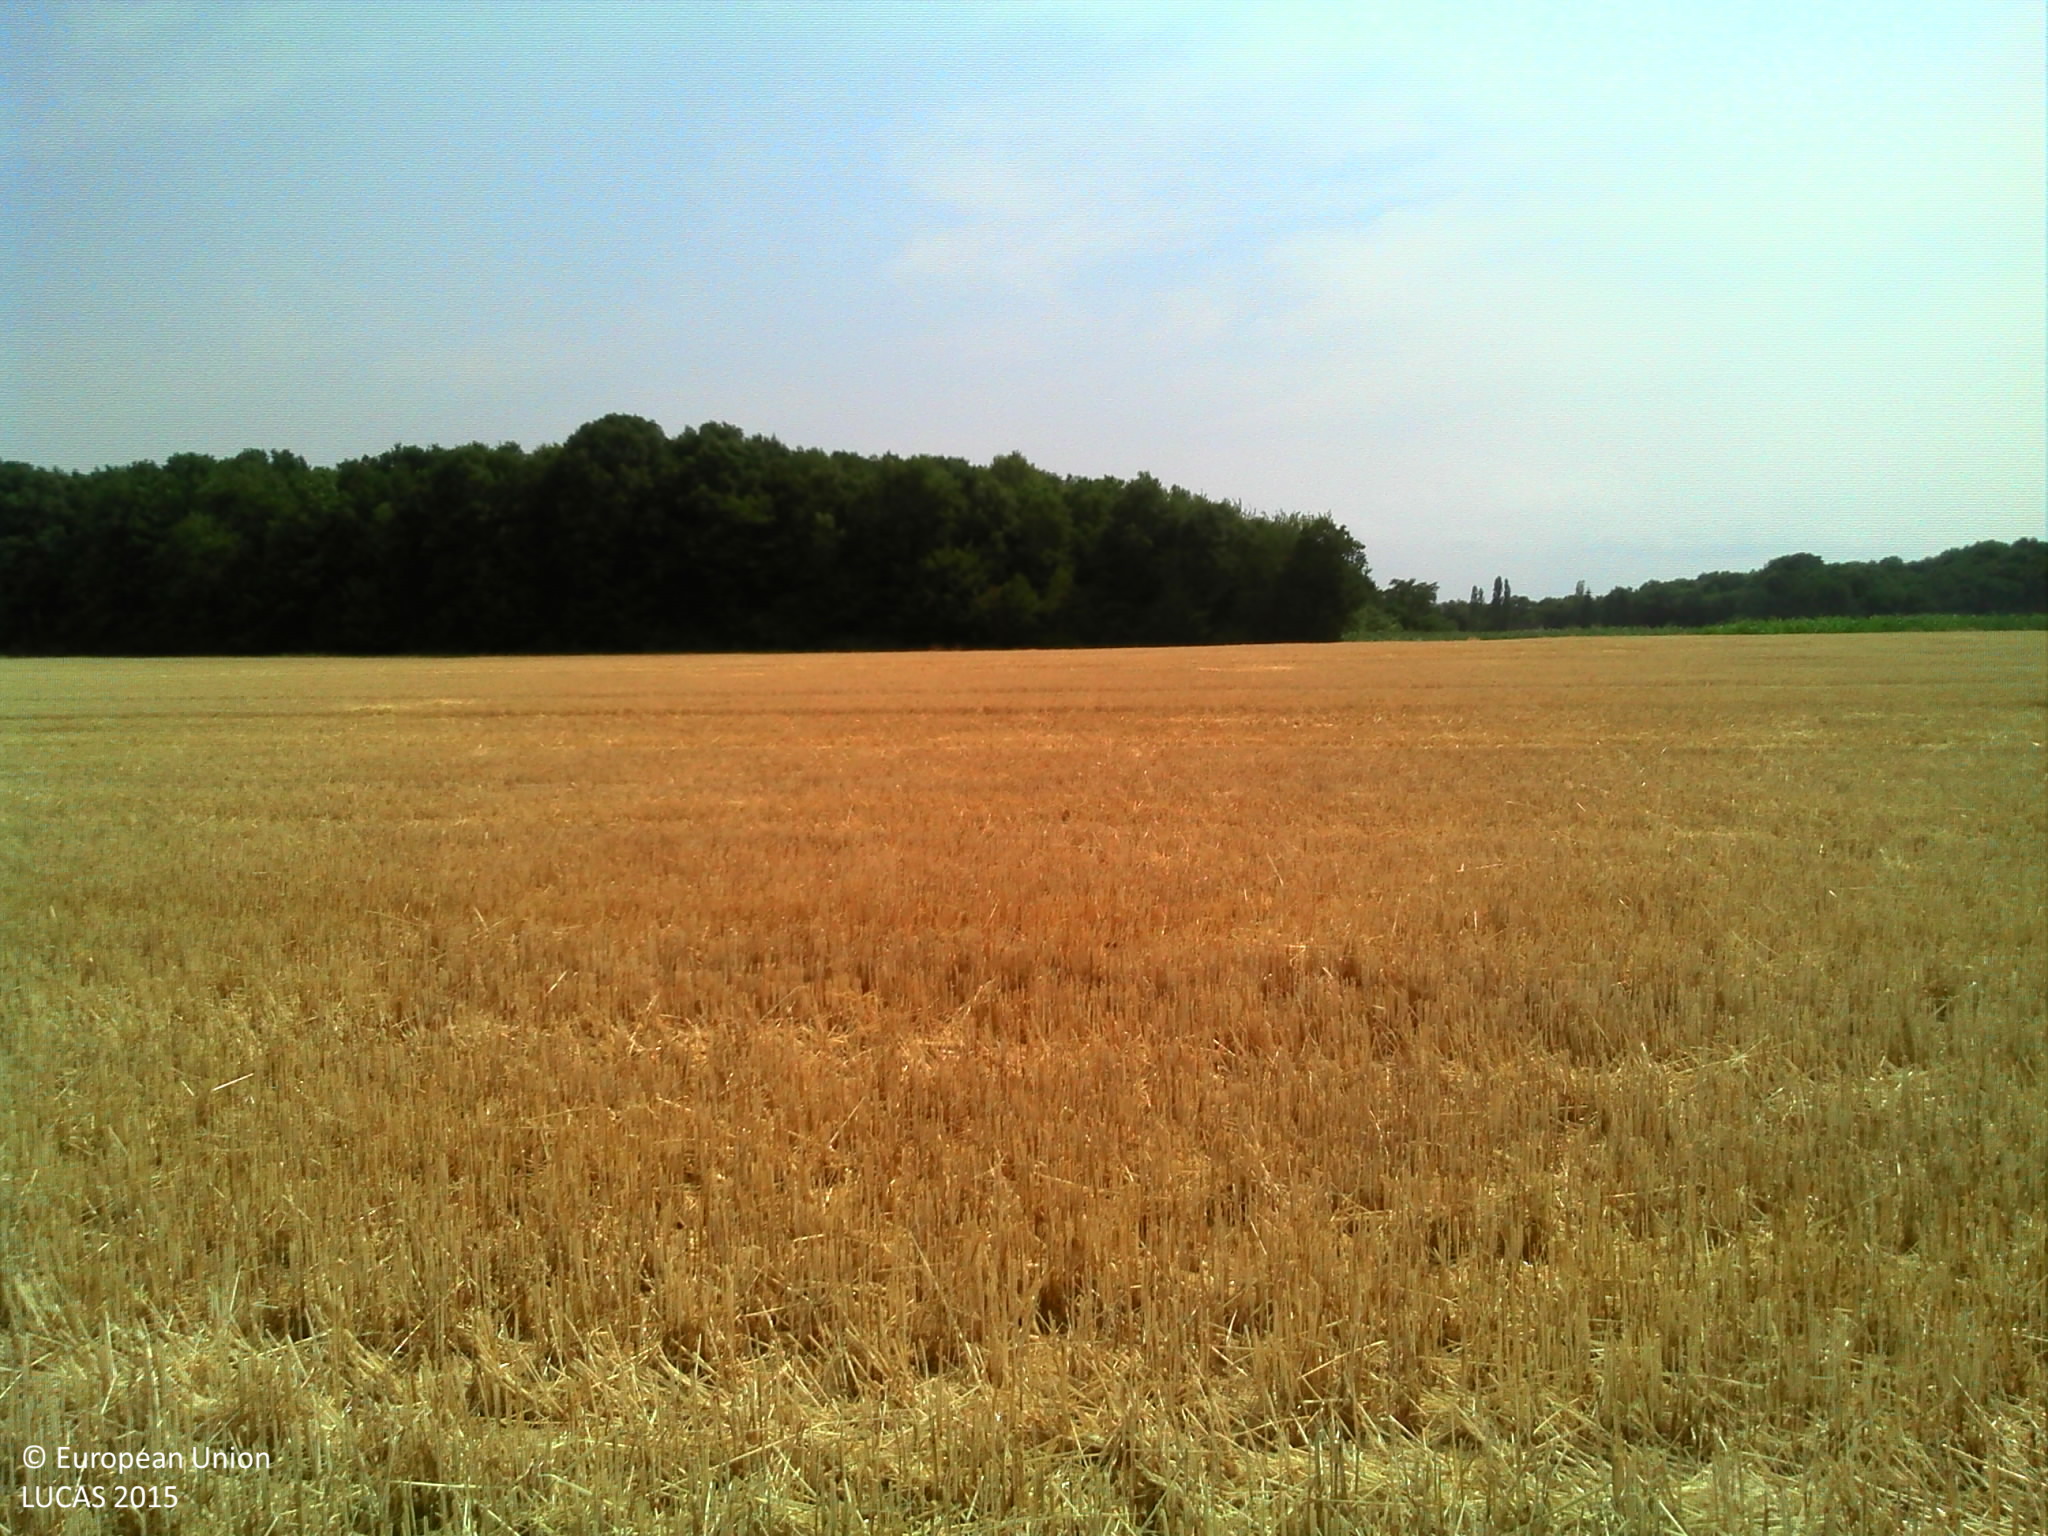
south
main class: Cropland
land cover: Barley
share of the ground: > 75 %
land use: Agriculture (excluding fallow land and kitchen gardens)
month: July
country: FR
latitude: 47.9716
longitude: 2.8257
